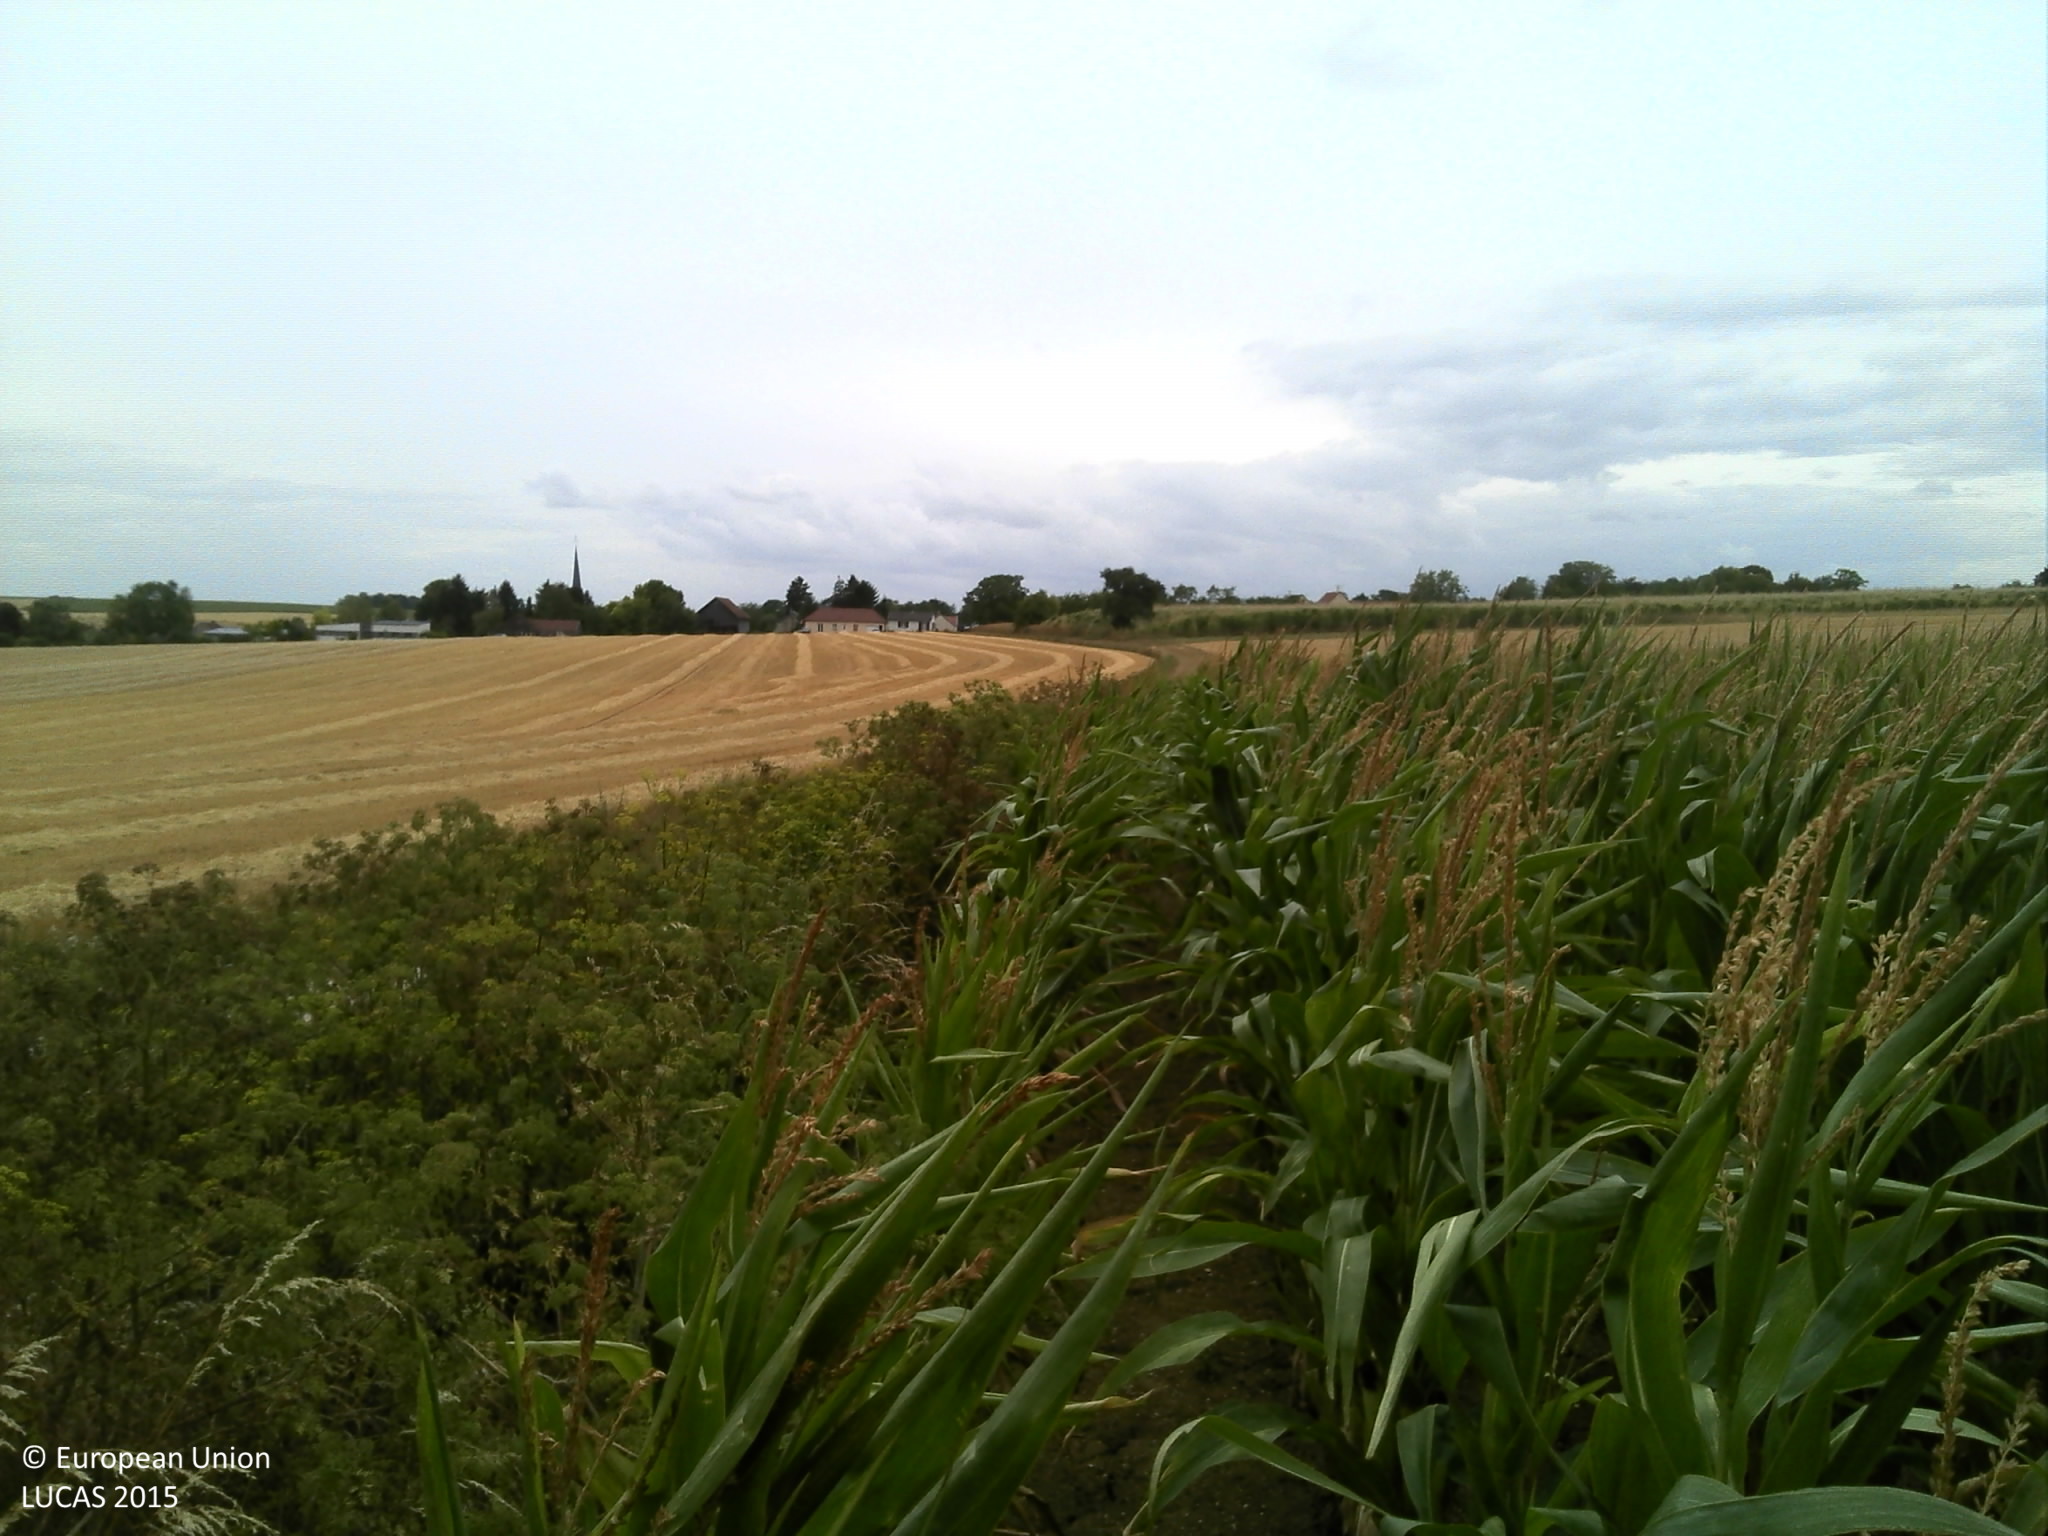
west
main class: Cropland
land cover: Maize
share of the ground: > 75 %
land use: Agriculture (excluding fallow land and kitchen gardens)
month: July
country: FR
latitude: 49.5085
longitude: 4.0980
